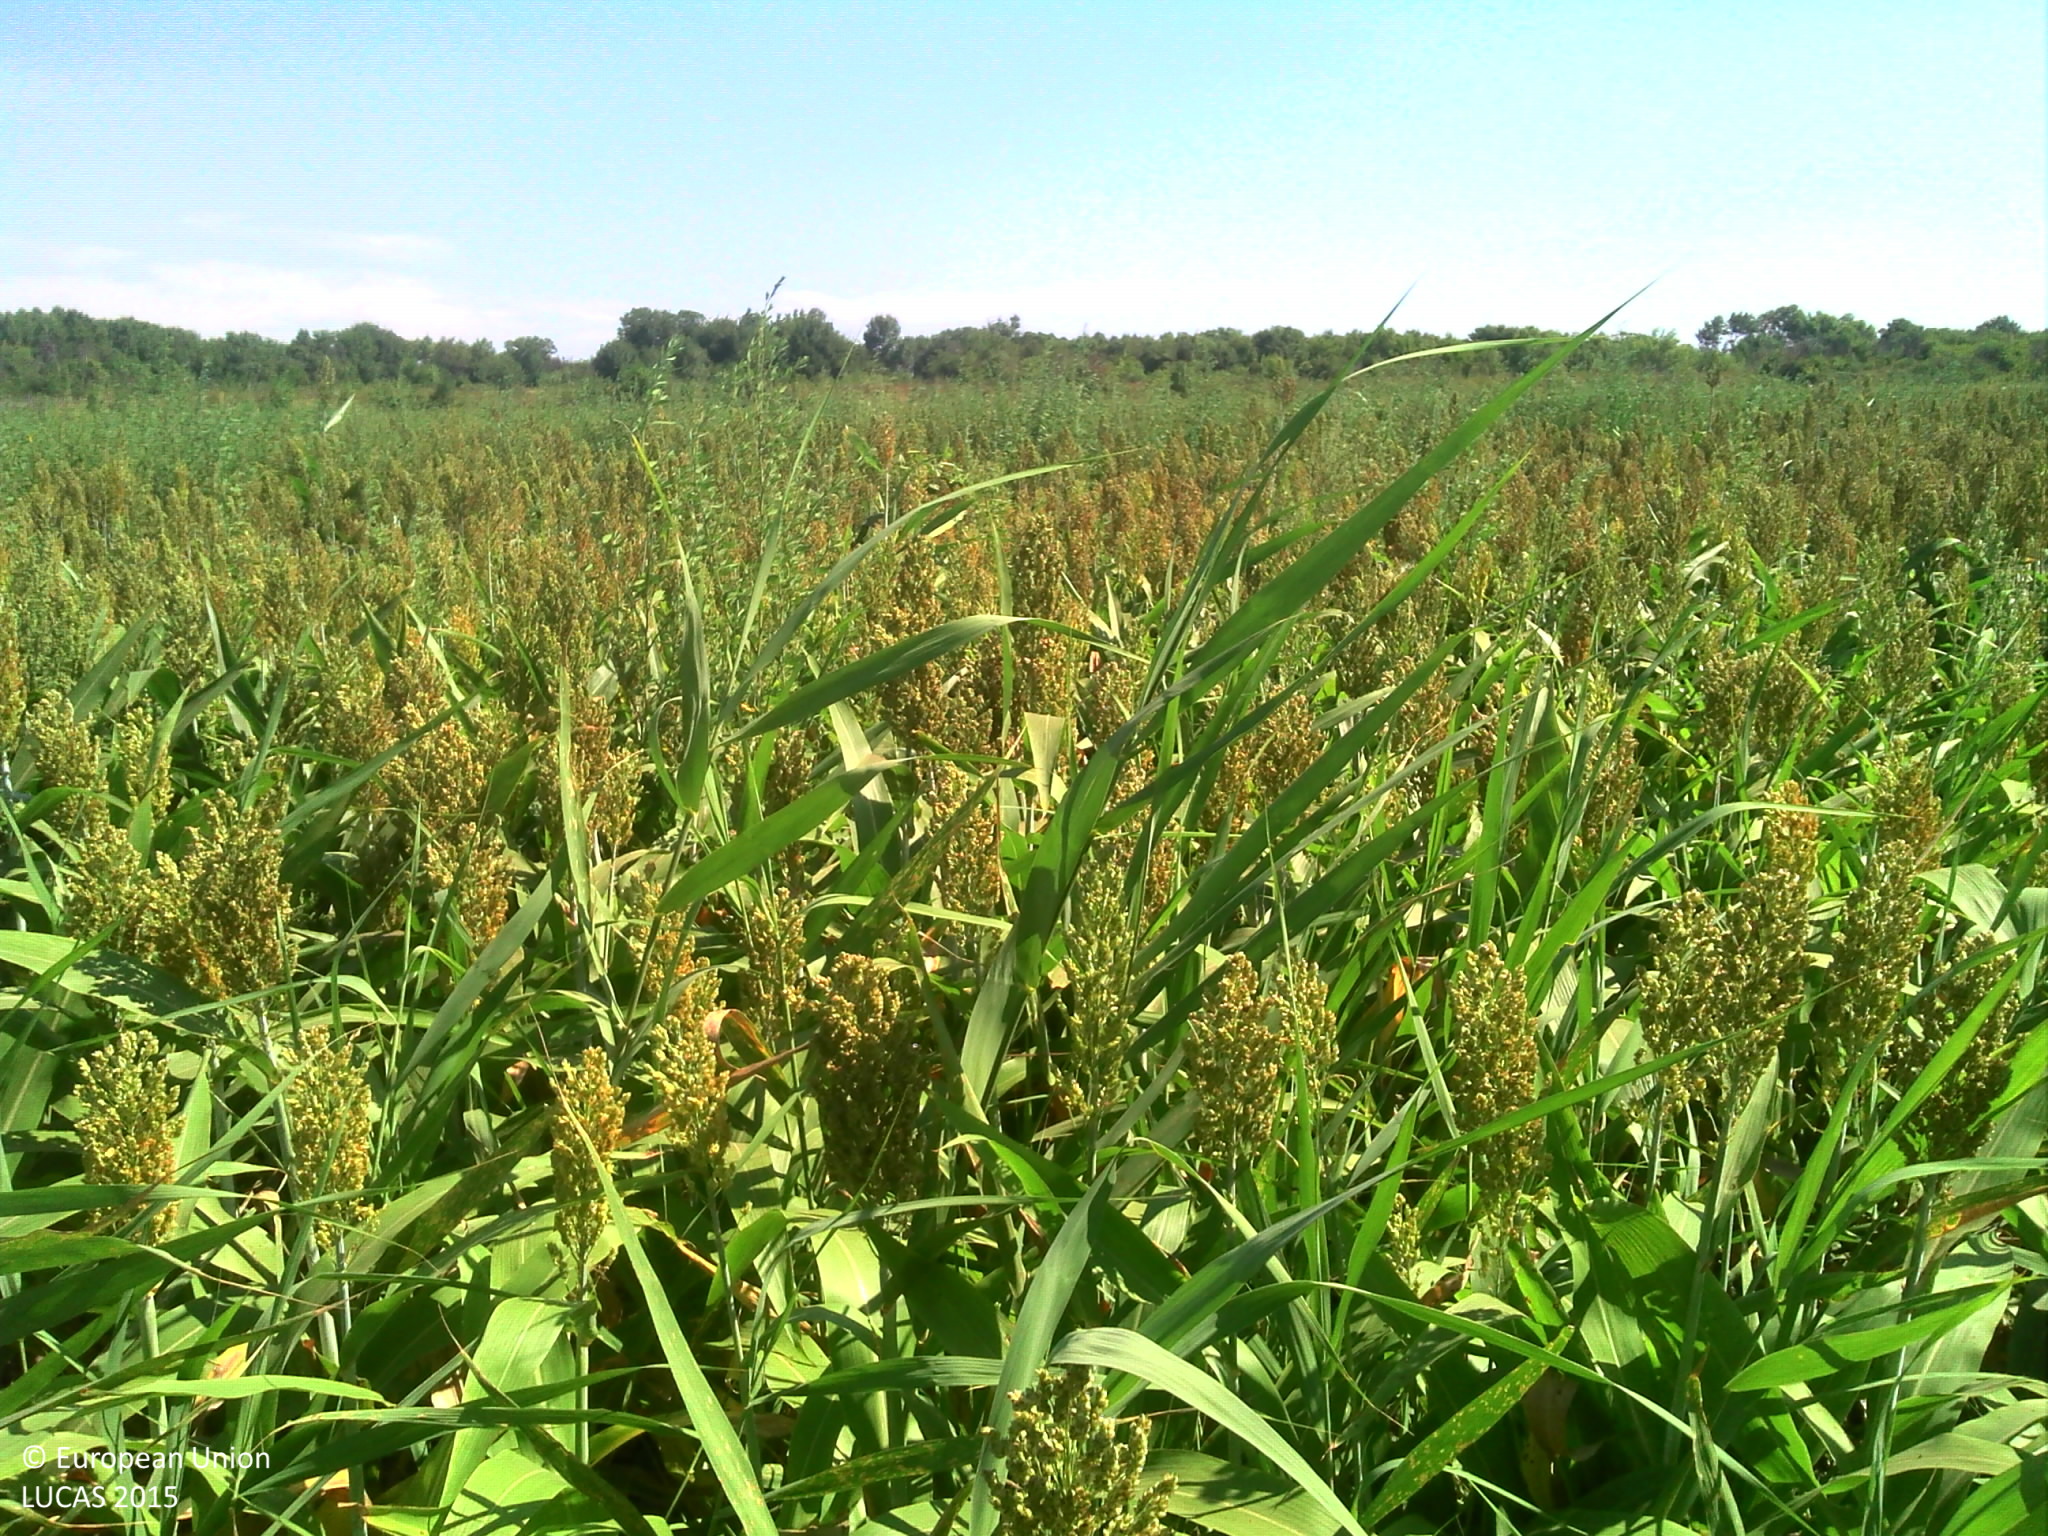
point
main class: Cropland
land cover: Other cereals
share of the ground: > 75 %
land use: Agriculture (excluding fallow land and kitchen gardens)
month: July
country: FR
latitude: 43.5823
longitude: 4.6969
